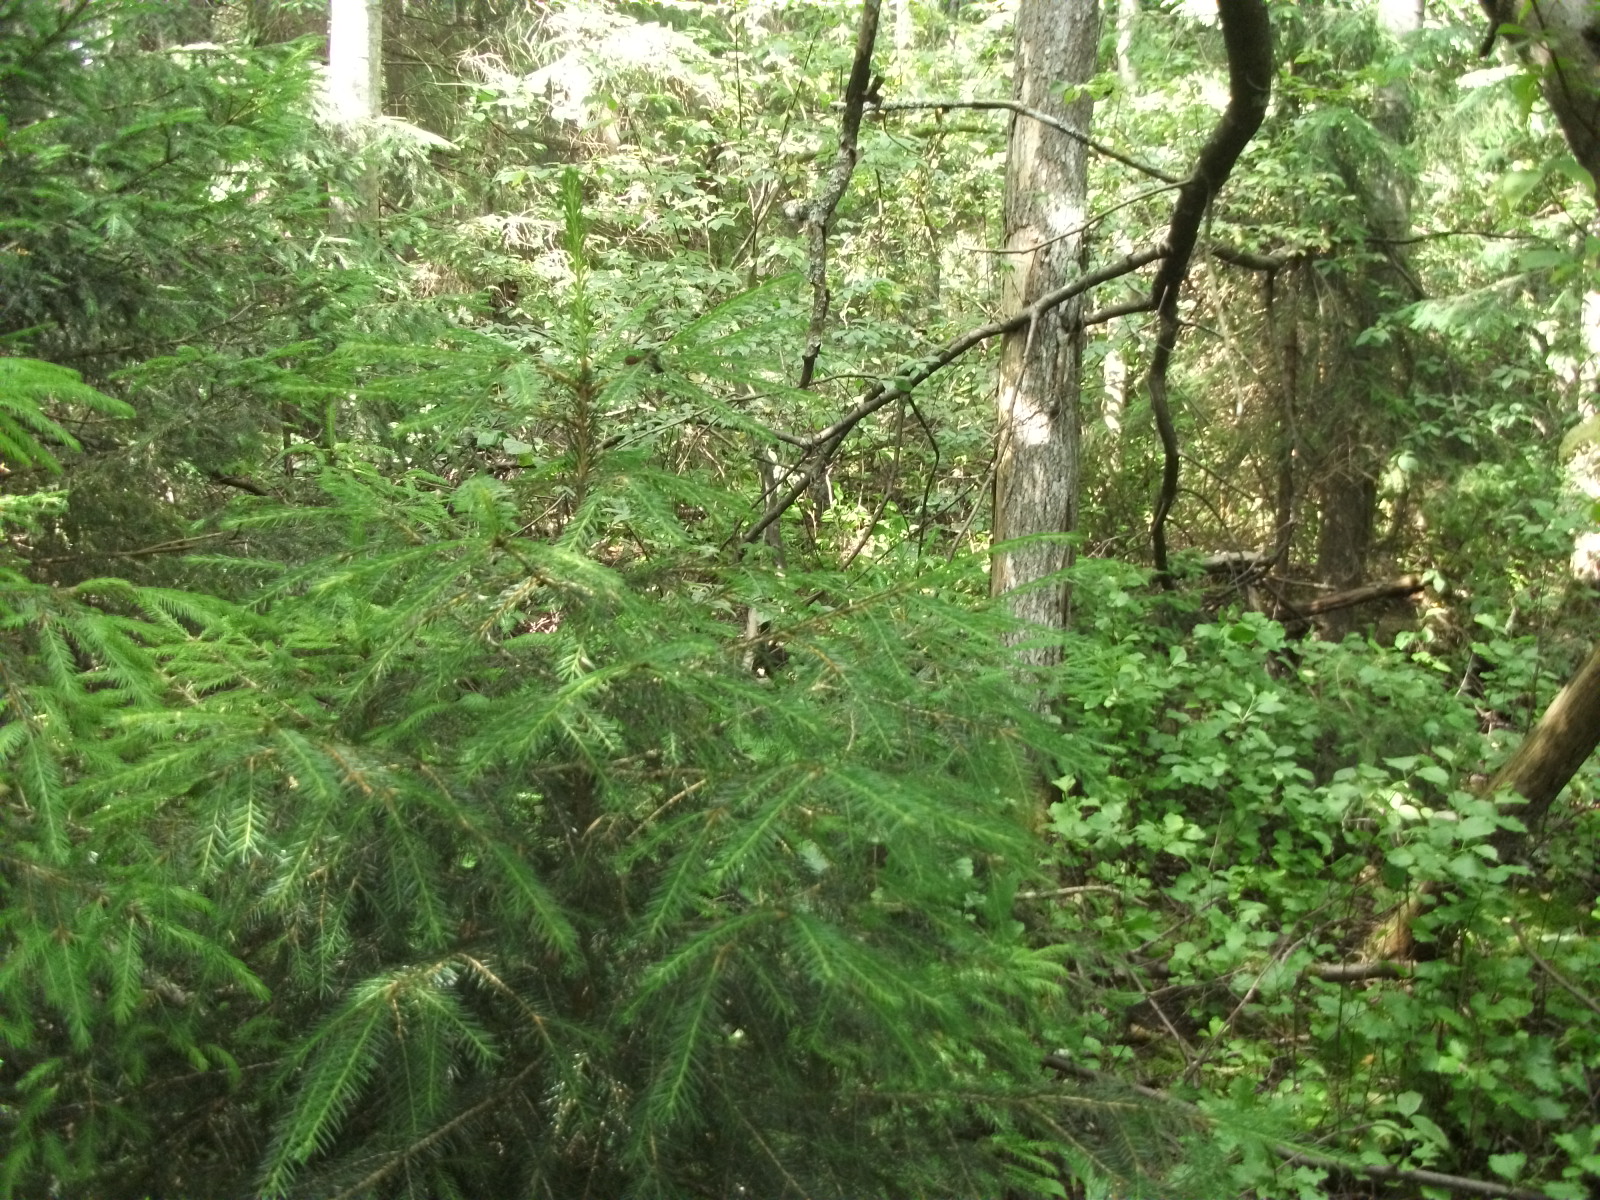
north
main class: Woodland
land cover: Spruce dominated mixed woodland
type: hemiboreal forest and nemoral coniferous forest and mixed broadleaved-coniferous forest
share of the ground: > 75 %
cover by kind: coniferous forest trees 60 %, broadleaved forest trees 30 %, herbaceous plants 10 %
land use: Forestry
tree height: > 5 m
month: July
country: LV
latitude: 57.1301
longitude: 25.9387
